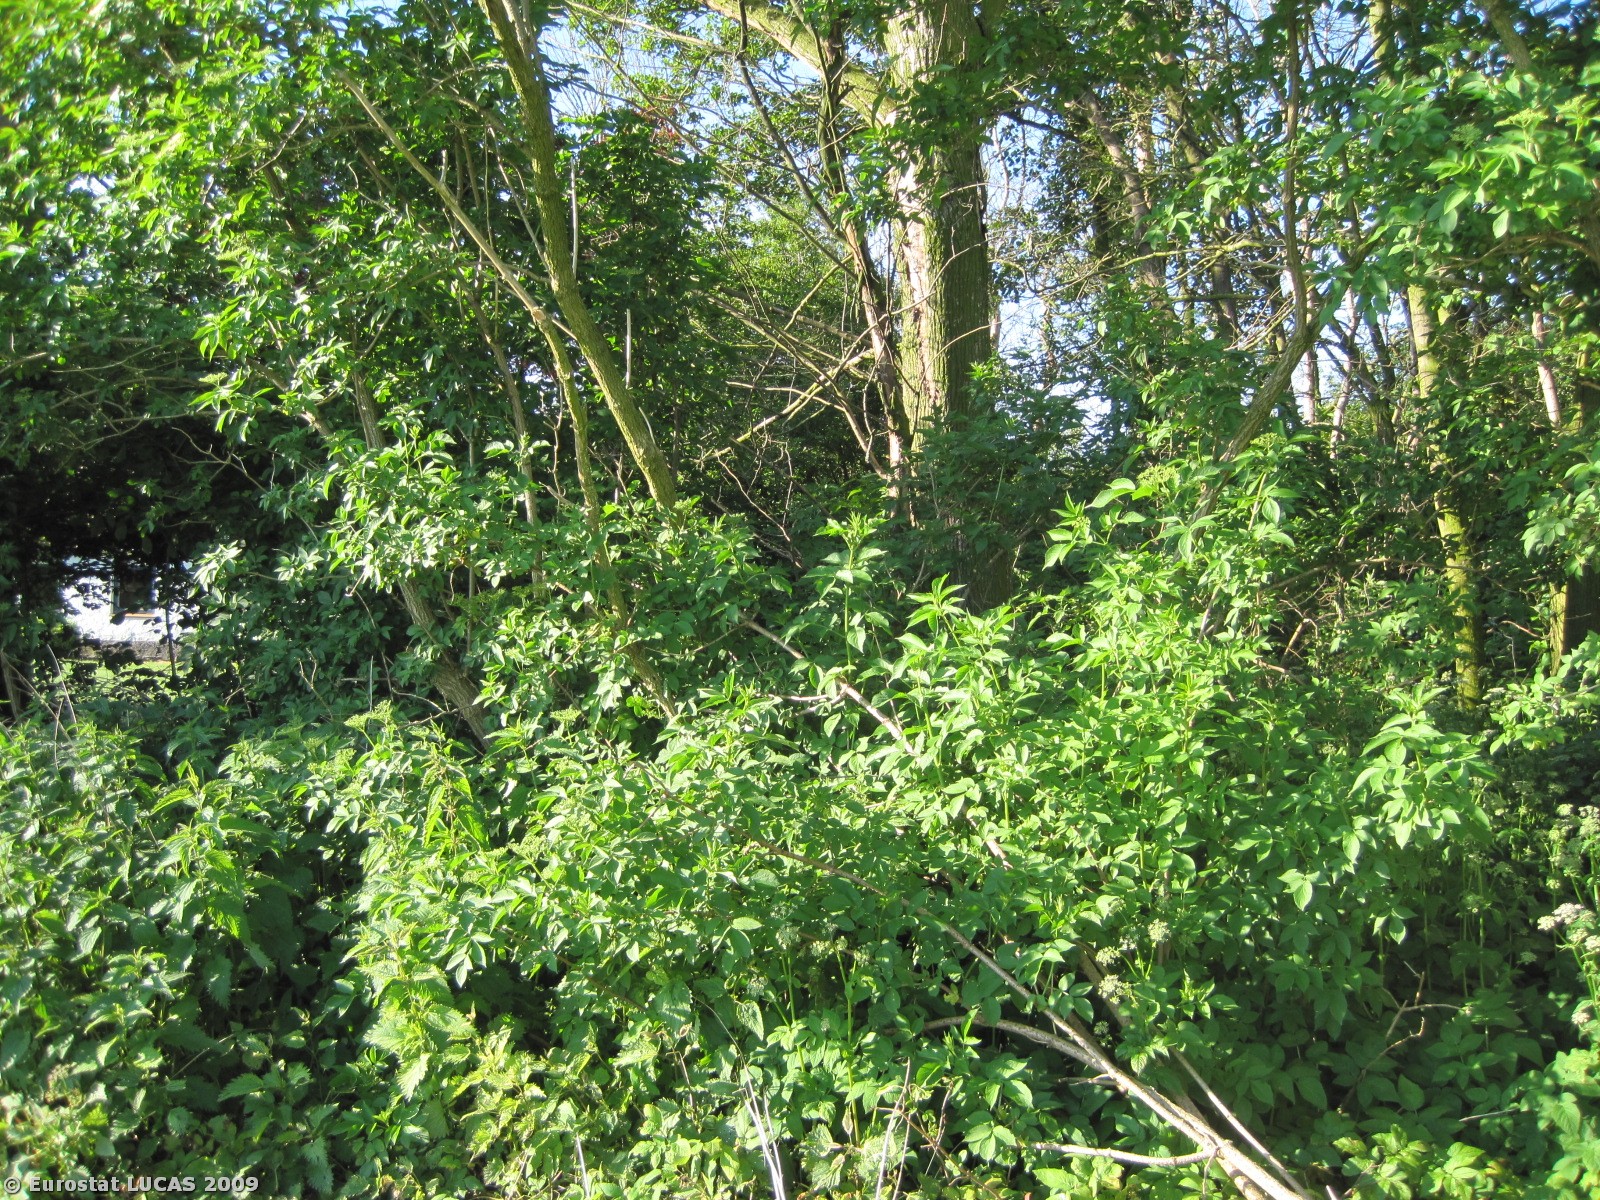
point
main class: Woodland
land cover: Broadleaved woodland
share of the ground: > 75 %
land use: Residential
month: June
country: DK
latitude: 57.4821
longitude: 9.8834
